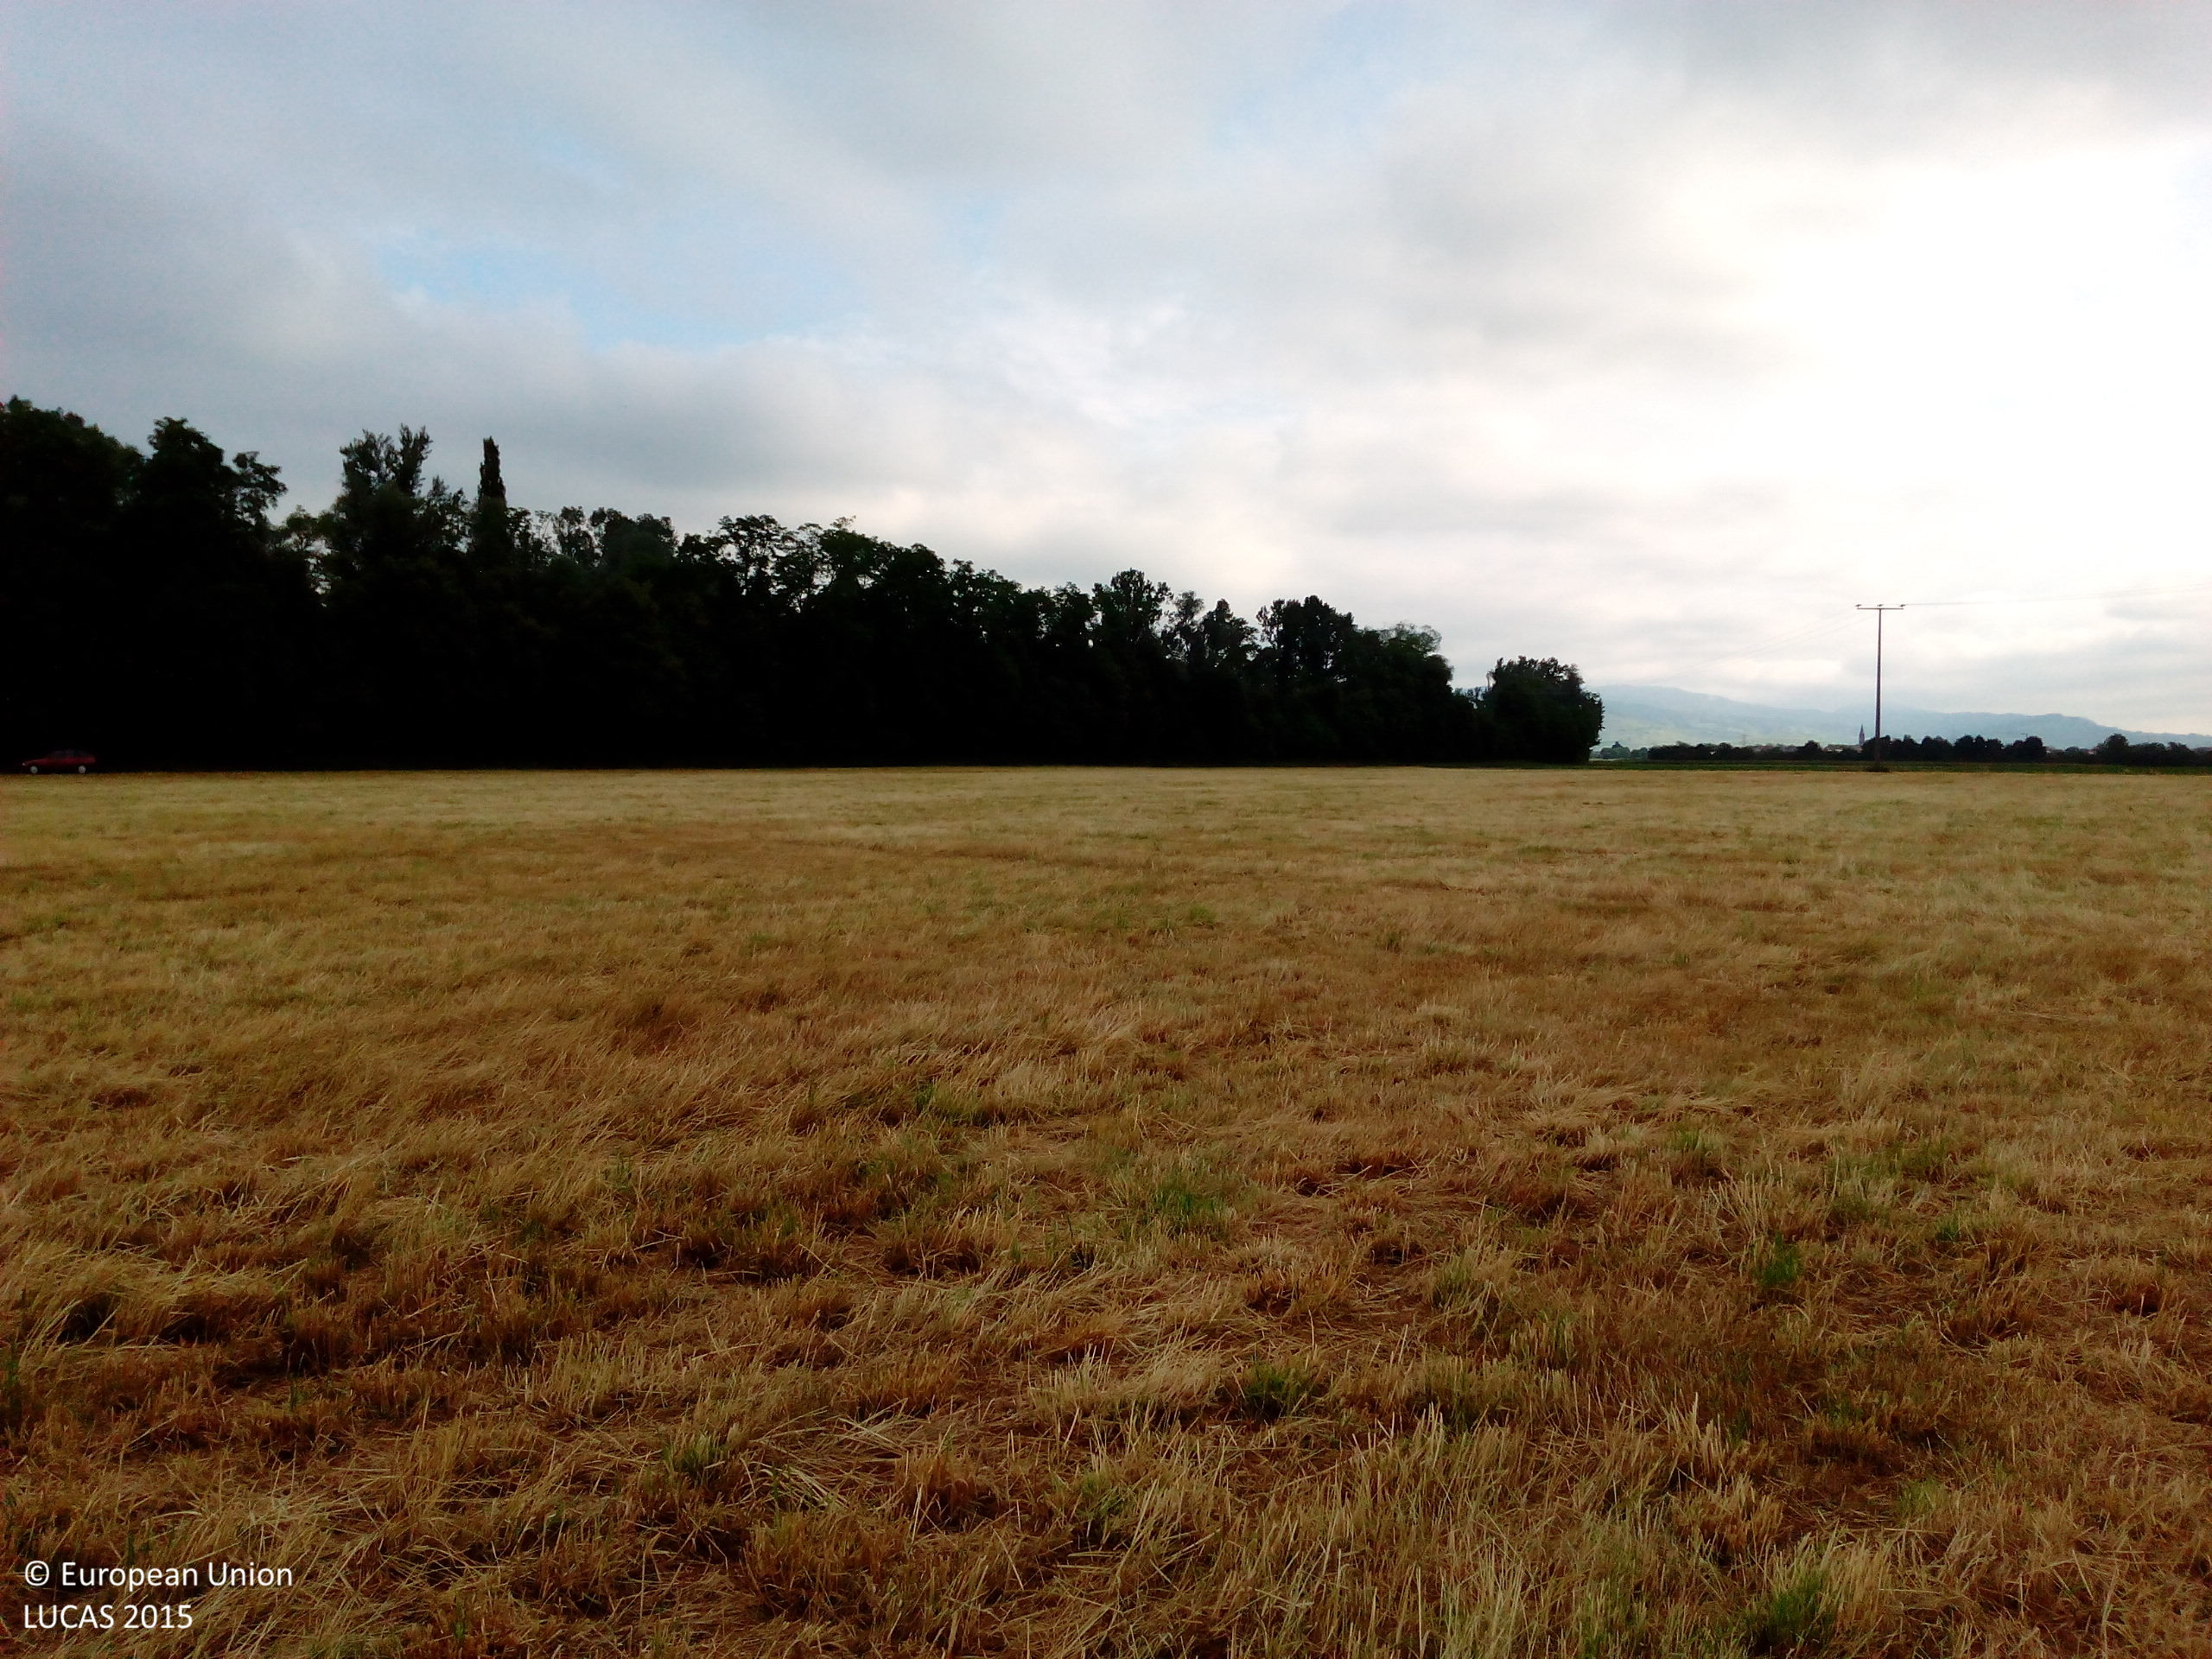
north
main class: Grassland
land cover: Grassland without tree/shrub cover
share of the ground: > 75 %
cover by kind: herbaceous plants 100 %
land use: Agriculture (excluding fallow land and kitchen gardens)
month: June
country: DE
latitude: 48.0000
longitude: 7.6289
